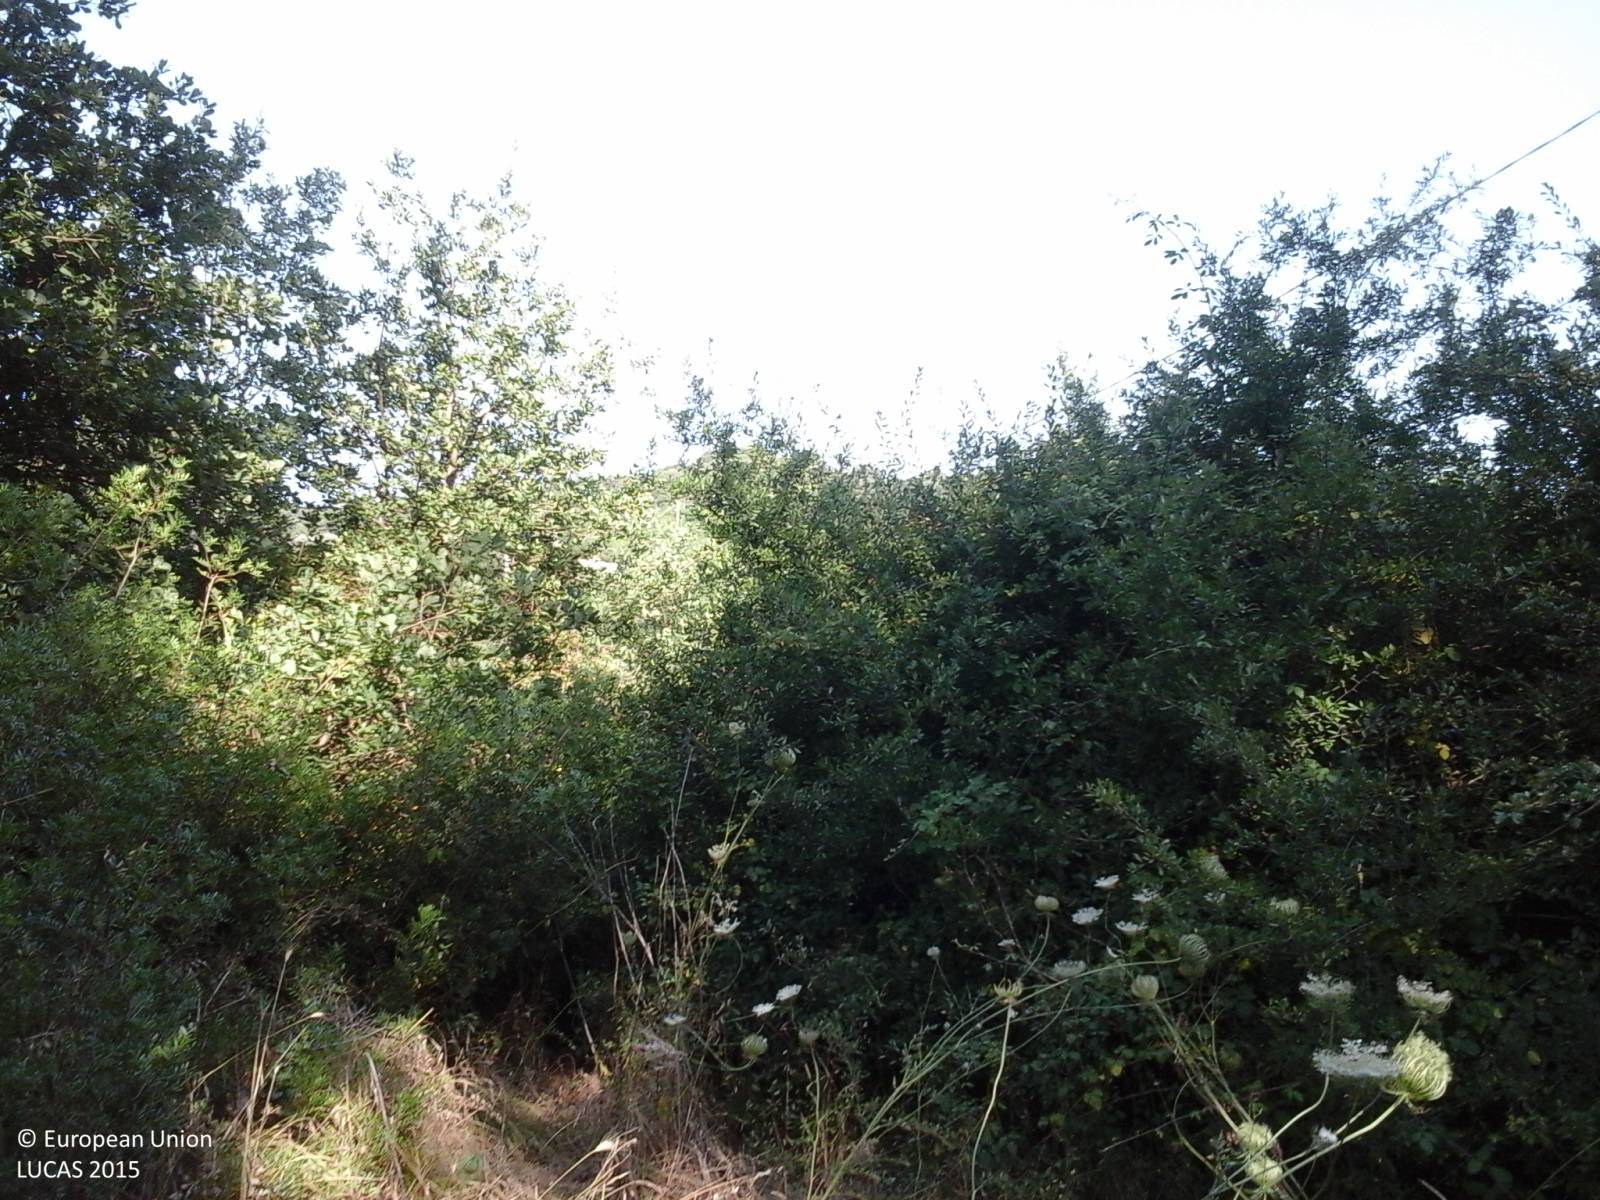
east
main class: Woodland
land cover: Broadleaved woodland
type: broadleaved evergreen forest
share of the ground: 25 - 50 %
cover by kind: broadleaved forest trees 50 %, herbaceous plants 50 %
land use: Agriculture (excluding fallow land and kitchen gardens)
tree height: < 5 m
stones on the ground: < 10 %
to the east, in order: Broadleaved woodland; Temporary grasslands; Abandoned hedges; Temporary grasslands; Abandoned hedges; Grassland without tree/shrub cover; Abandoned hedges; Paved roads, cycling and walking lanes; Dry stone walls; Abandoned hedges; Electric lines; Shrubland with sparse tree cover
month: July
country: IT
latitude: 40.0254
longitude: 8.8696
